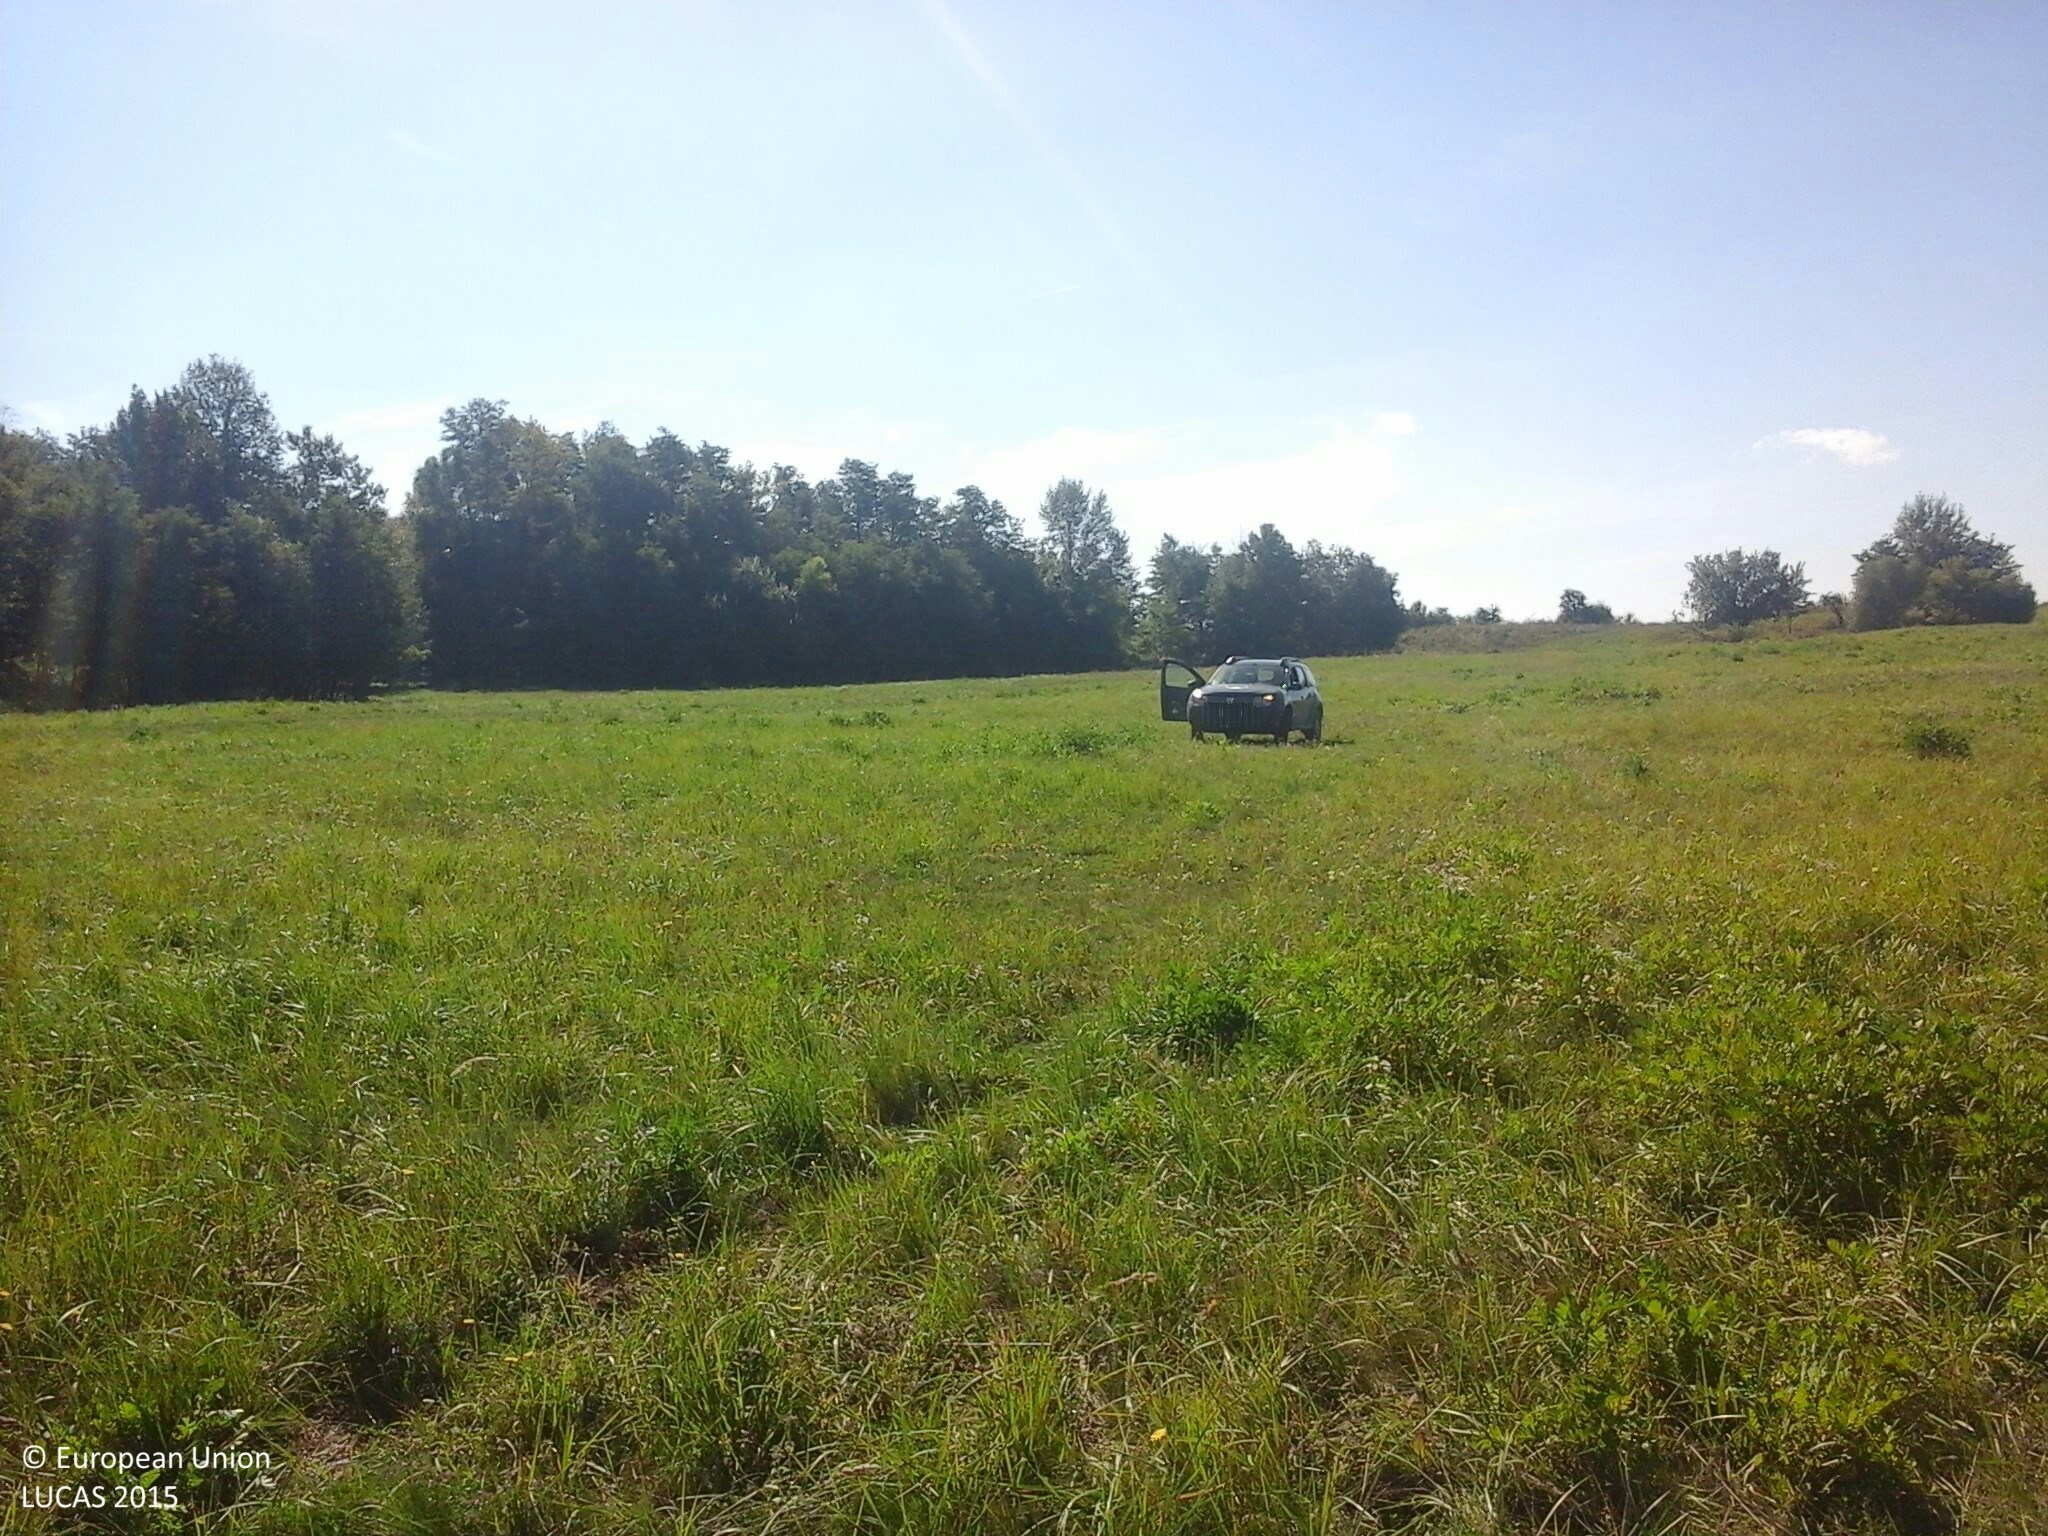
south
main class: Grassland
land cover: Grassland without tree/shrub cover
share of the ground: > 75 %
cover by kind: herbaceous plants 100 %
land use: Agriculture (excluding fallow land and kitchen gardens)
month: September
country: HU
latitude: 48.0499
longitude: 19.8874
